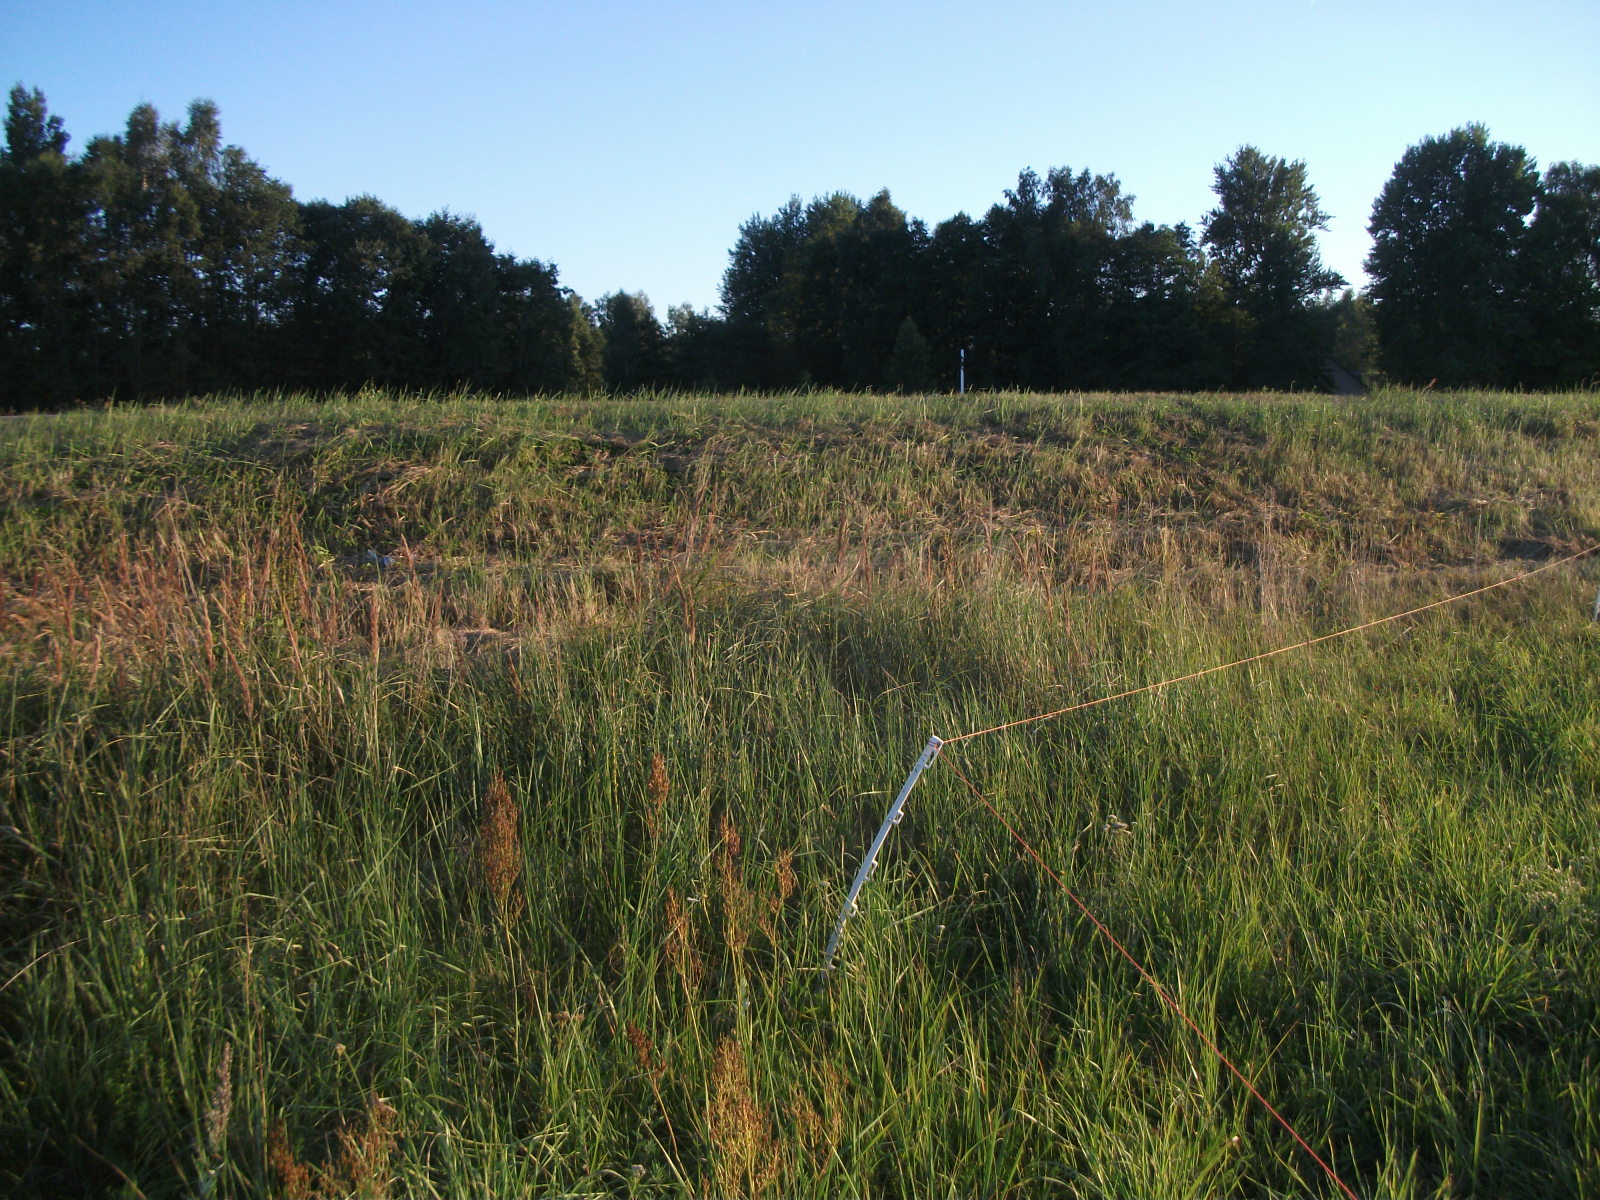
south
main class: Grassland
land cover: Grassland without tree/shrub cover
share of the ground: > 75 %
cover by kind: herbaceous plants 100 %
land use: Agriculture (excluding fallow land and kitchen gardens)
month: August
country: LV
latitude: 56.3479
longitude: 26.3073
